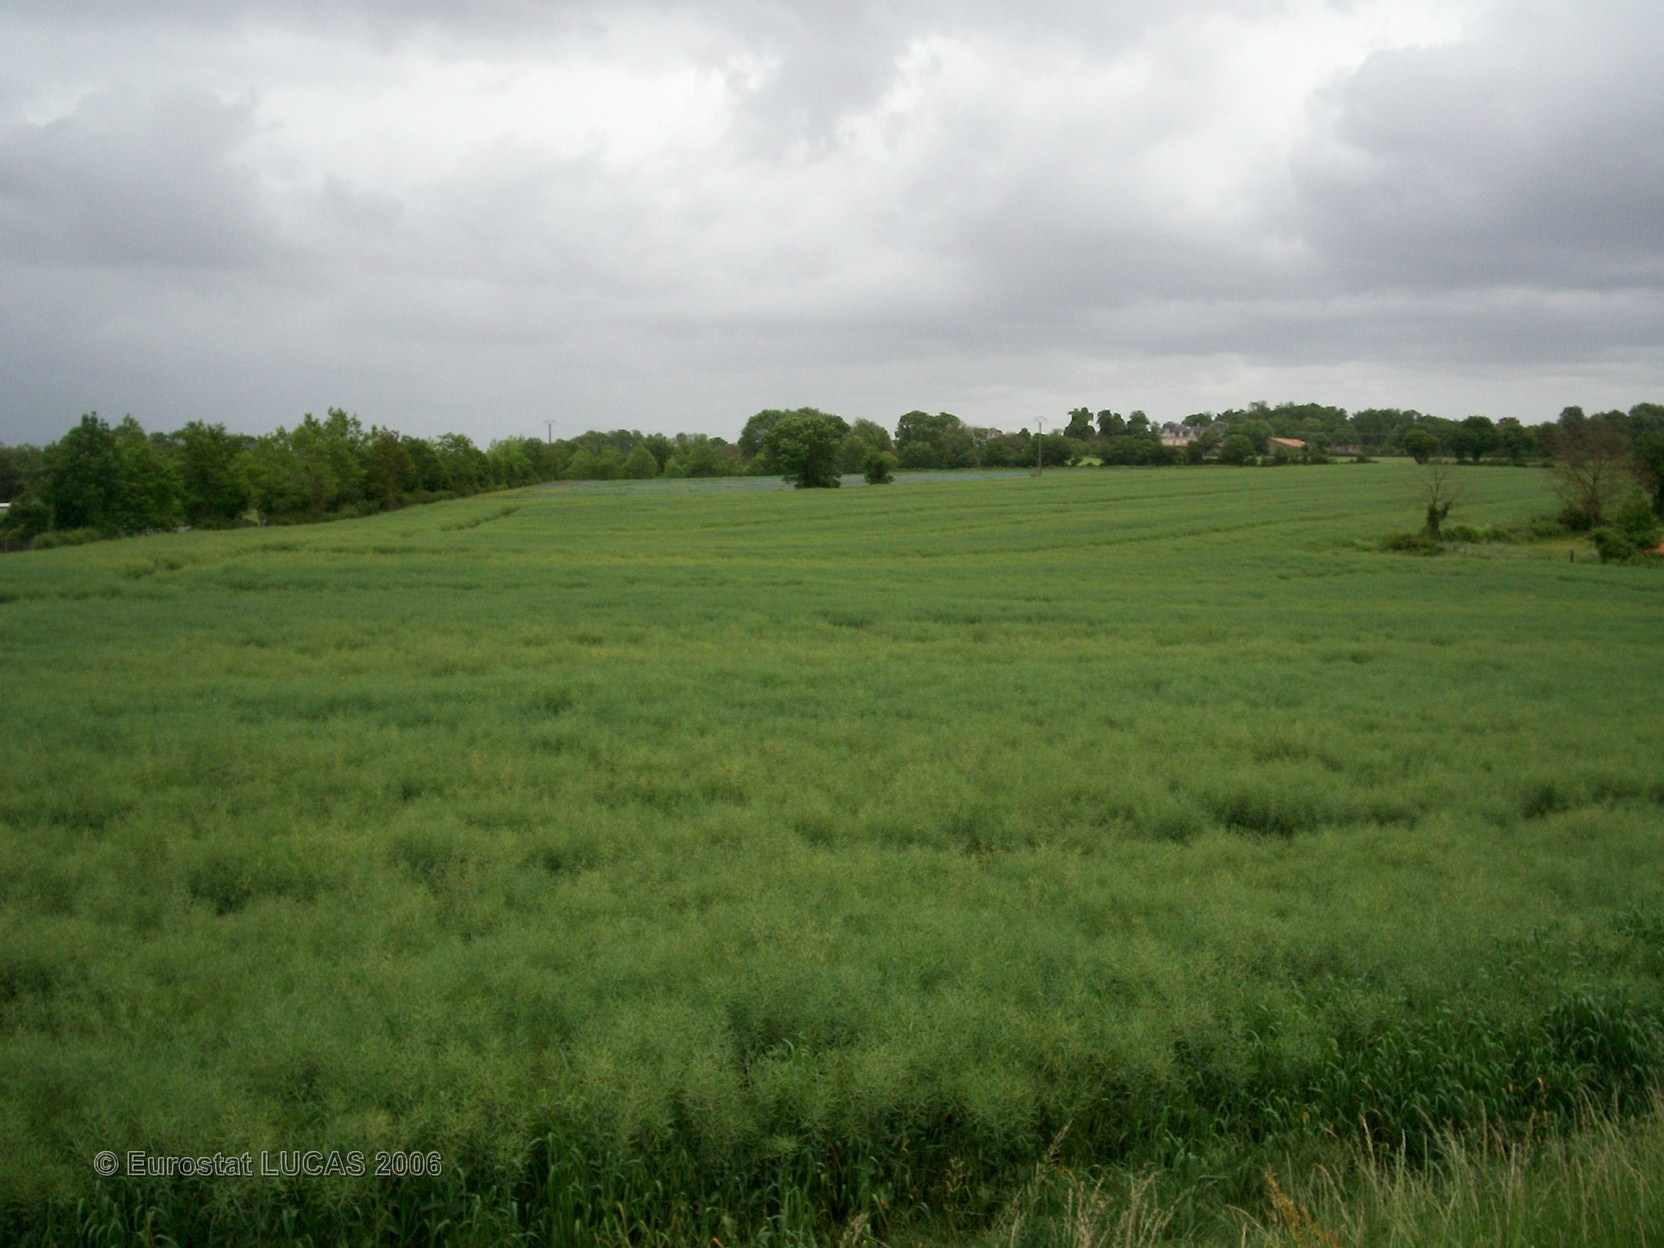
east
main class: Cropland
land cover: Rape and turnip rape
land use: Agriculture (excluding fallow land and kitchen gardens)
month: May
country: FR
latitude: 46.3679
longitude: -0.2273
